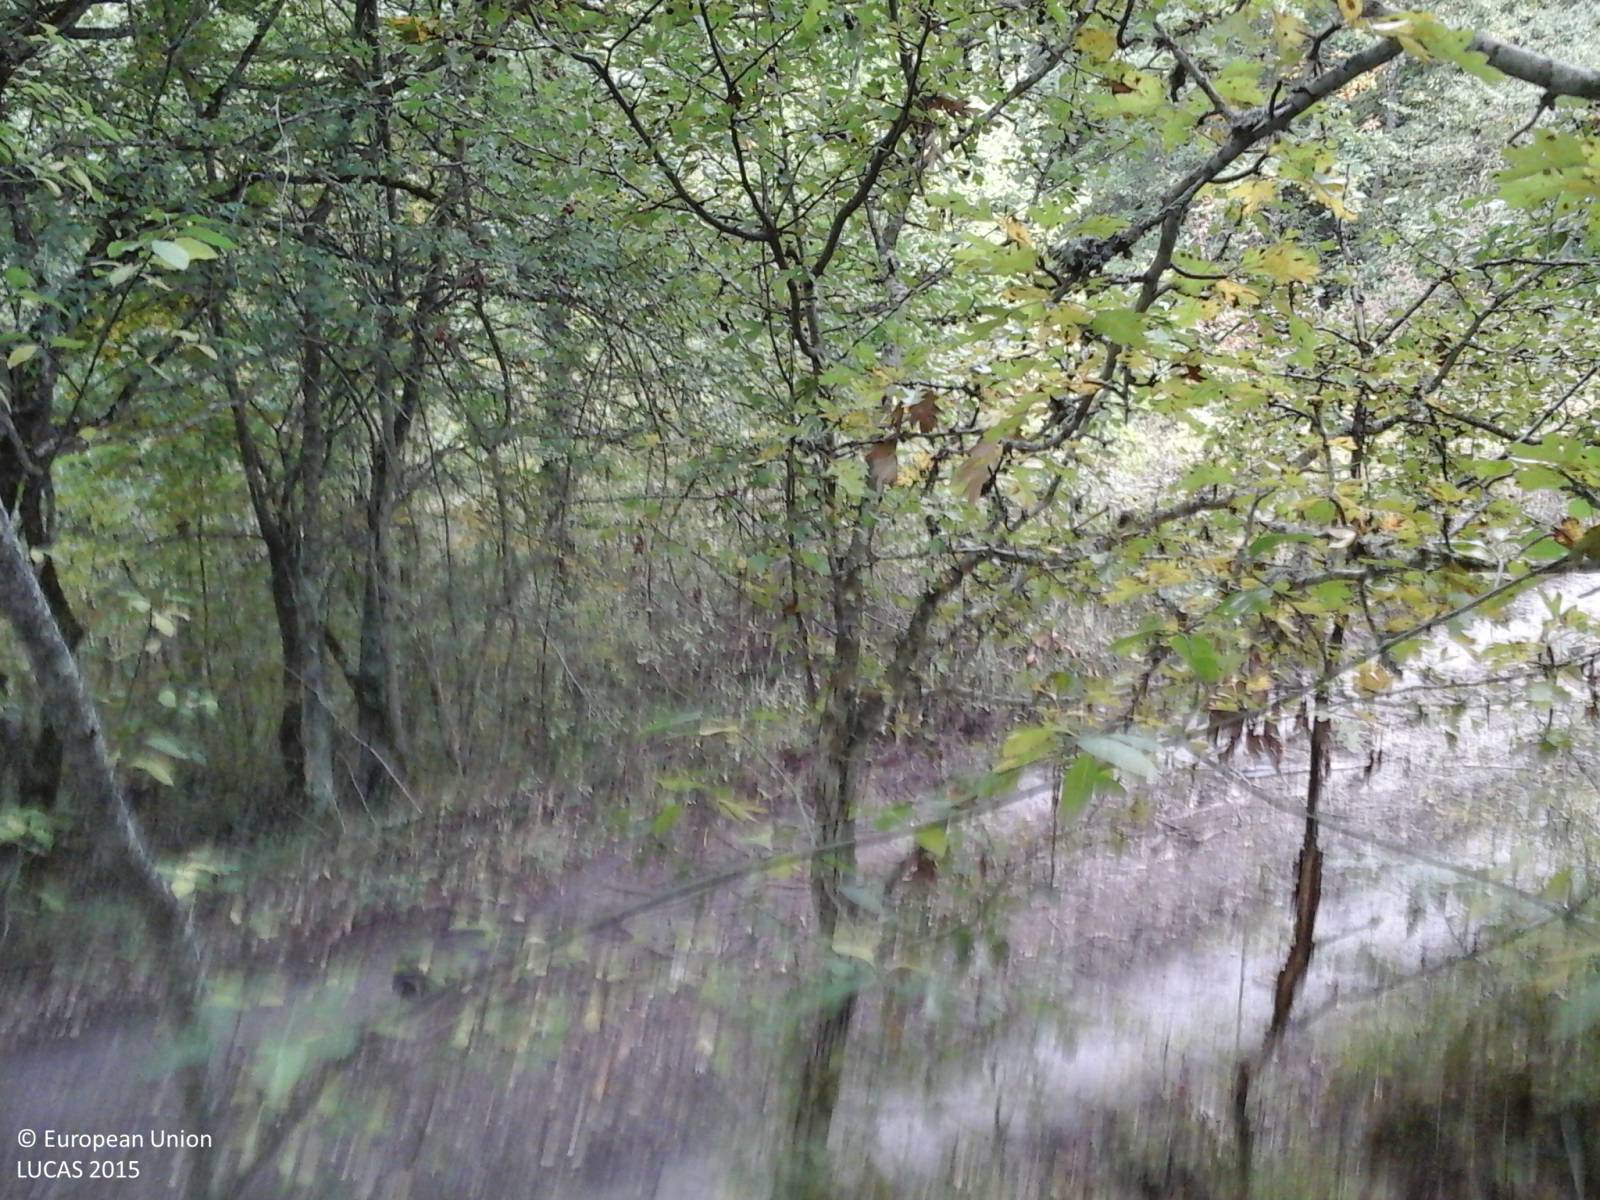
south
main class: Woodland
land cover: Broadleaved woodland
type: thermophilous deciduous forest
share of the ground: > 75 %
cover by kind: broadleaved forest trees 90 %, shrubs 10 %
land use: Forestry
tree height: > 5 m
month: October
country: IT
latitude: 42.6578
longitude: 13.1986
